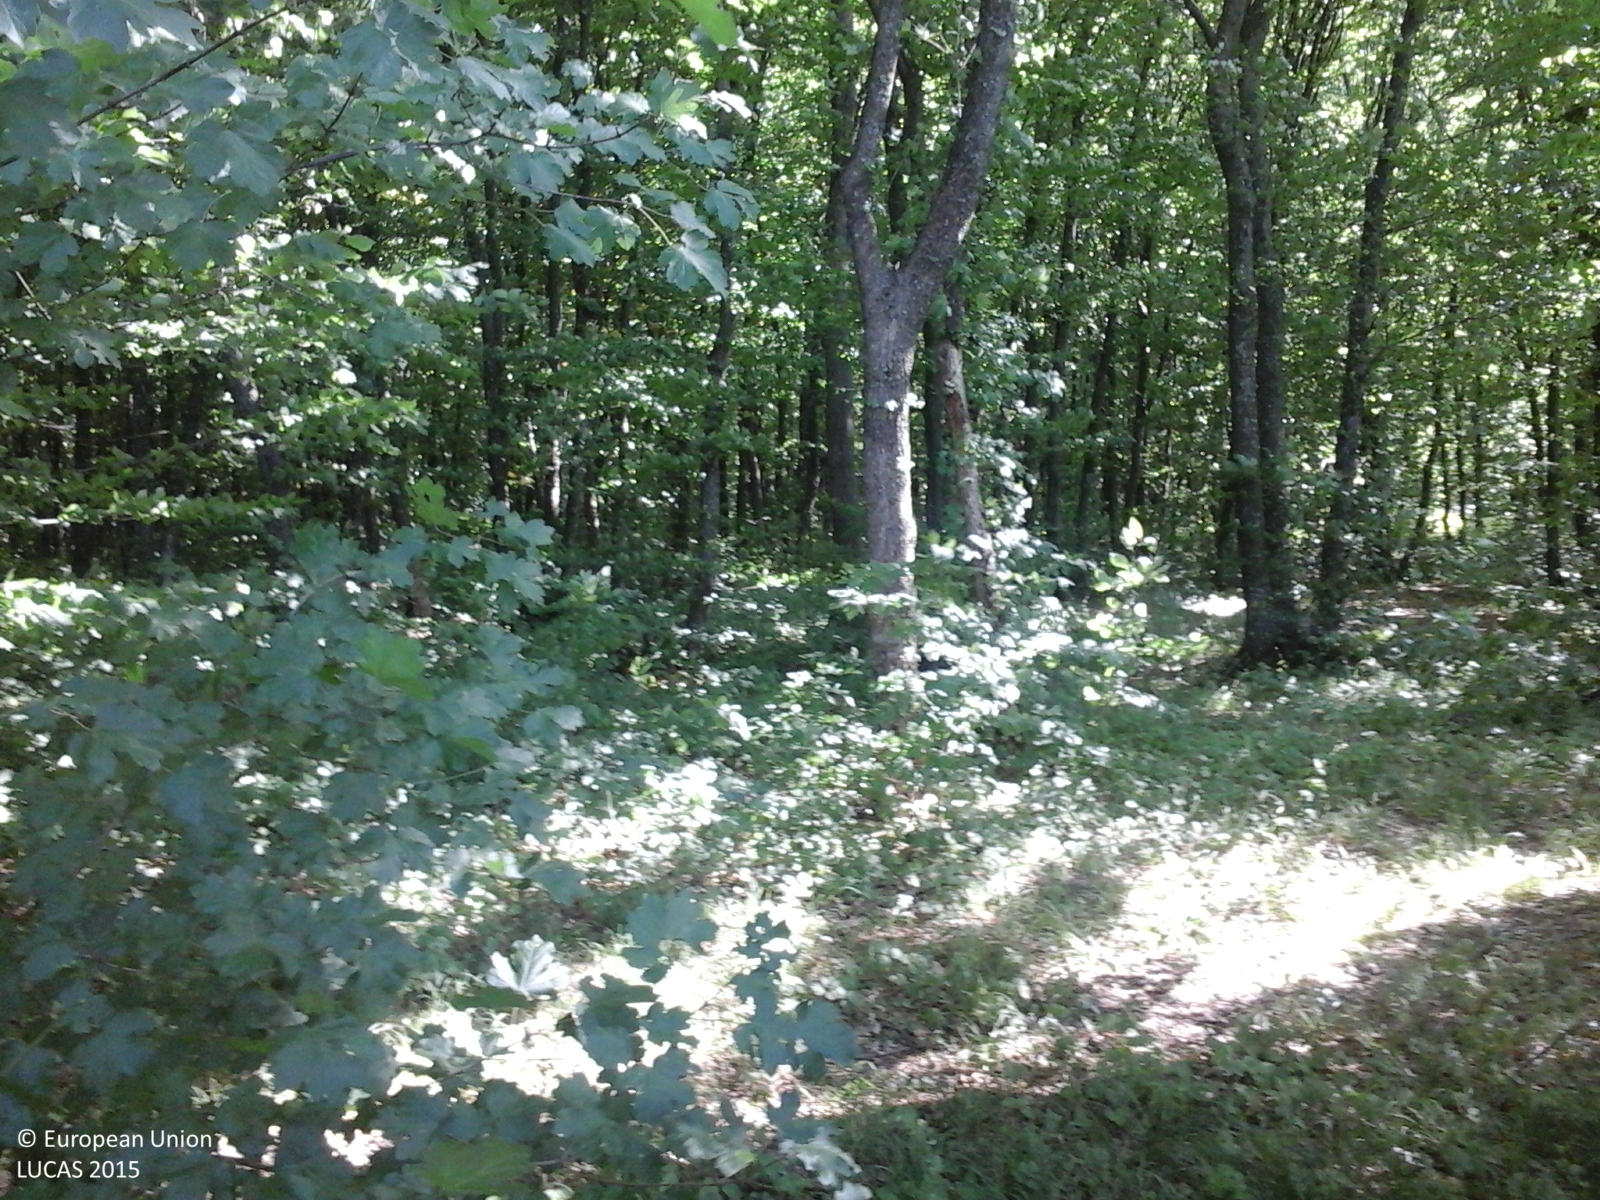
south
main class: Woodland
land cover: Broadleaved woodland
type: acidophilous oak and oak-birch forest
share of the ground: > 75 %
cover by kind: broadleaved forest trees 85 %, herbaceous plants 10 %, shrubs 5 %
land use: Forestry
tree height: > 5 m
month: June
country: RO
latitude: 46.7619
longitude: 28.0008
